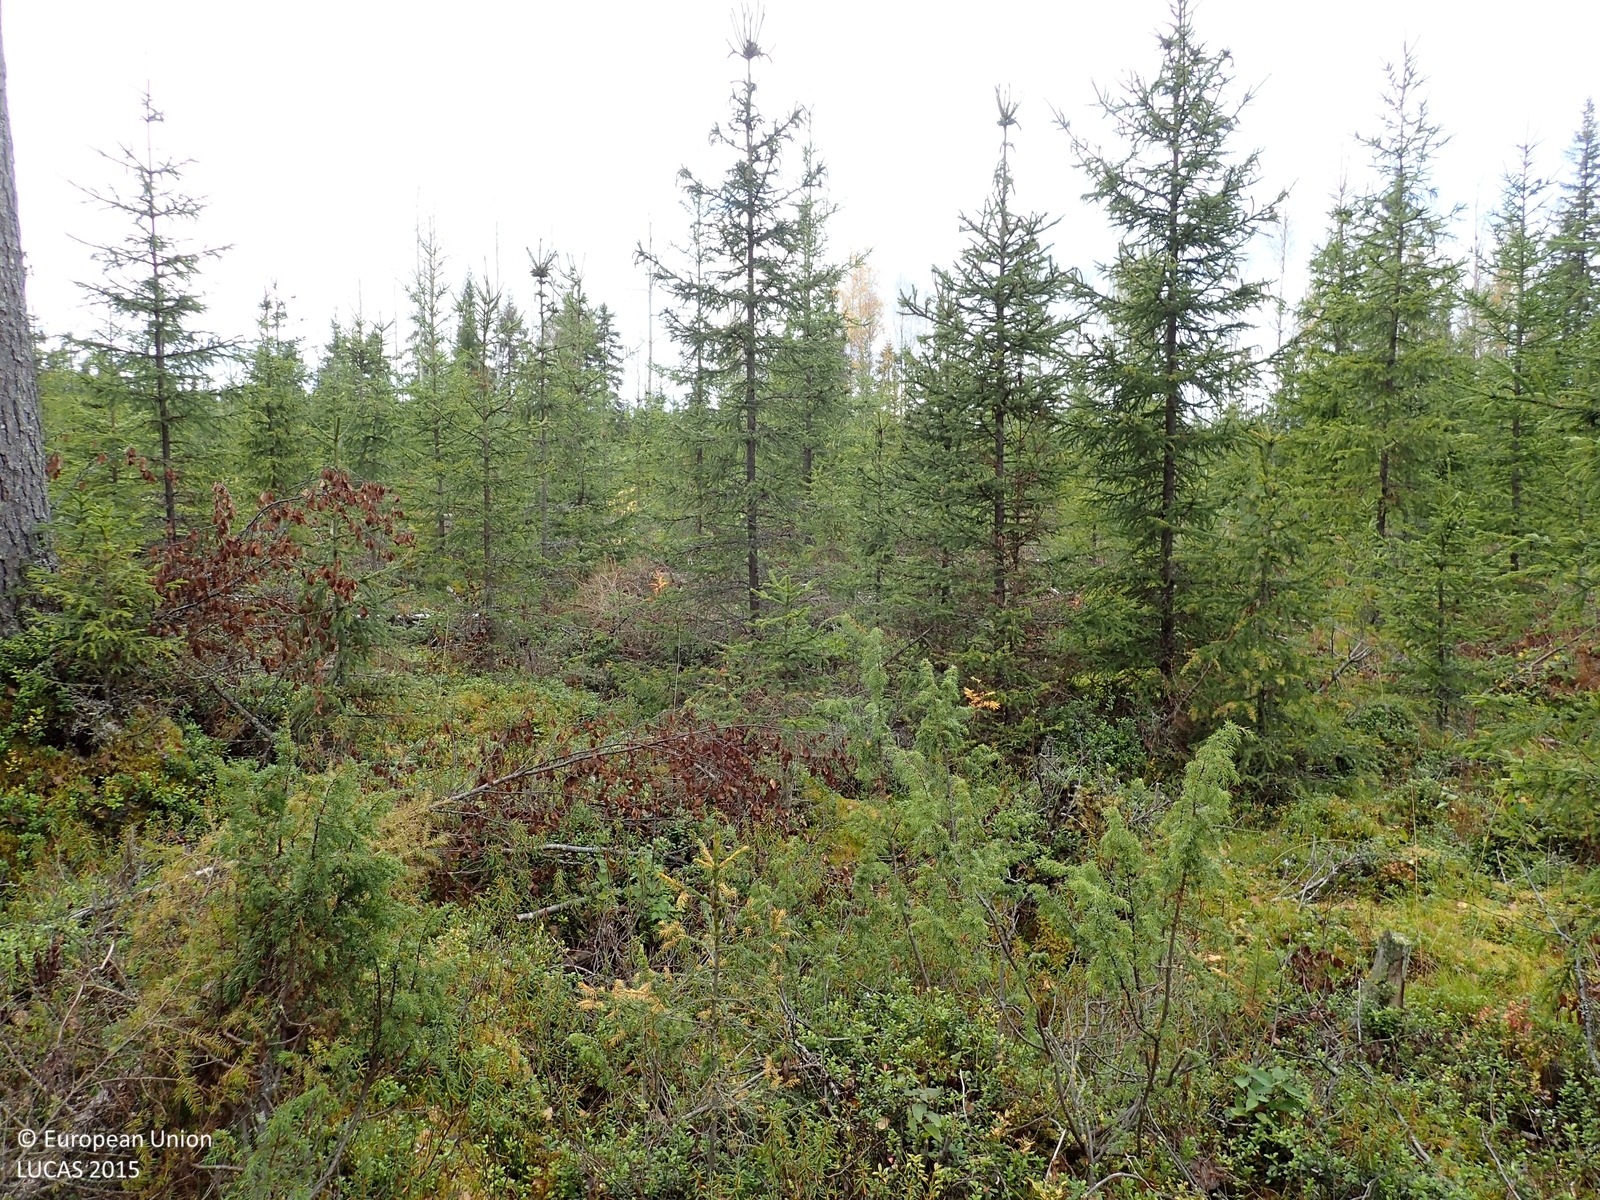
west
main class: Woodland
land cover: Spruce dominated coniferous woodland
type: boreal forest
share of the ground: 50 - 75 %
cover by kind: coniferous forest trees 50 %, shrubs 45 %, lichens and mosses 5 %
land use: Forestry
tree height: < 5 m
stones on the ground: < 10 %
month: September
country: FI
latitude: 63.2874
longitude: 25.2319
